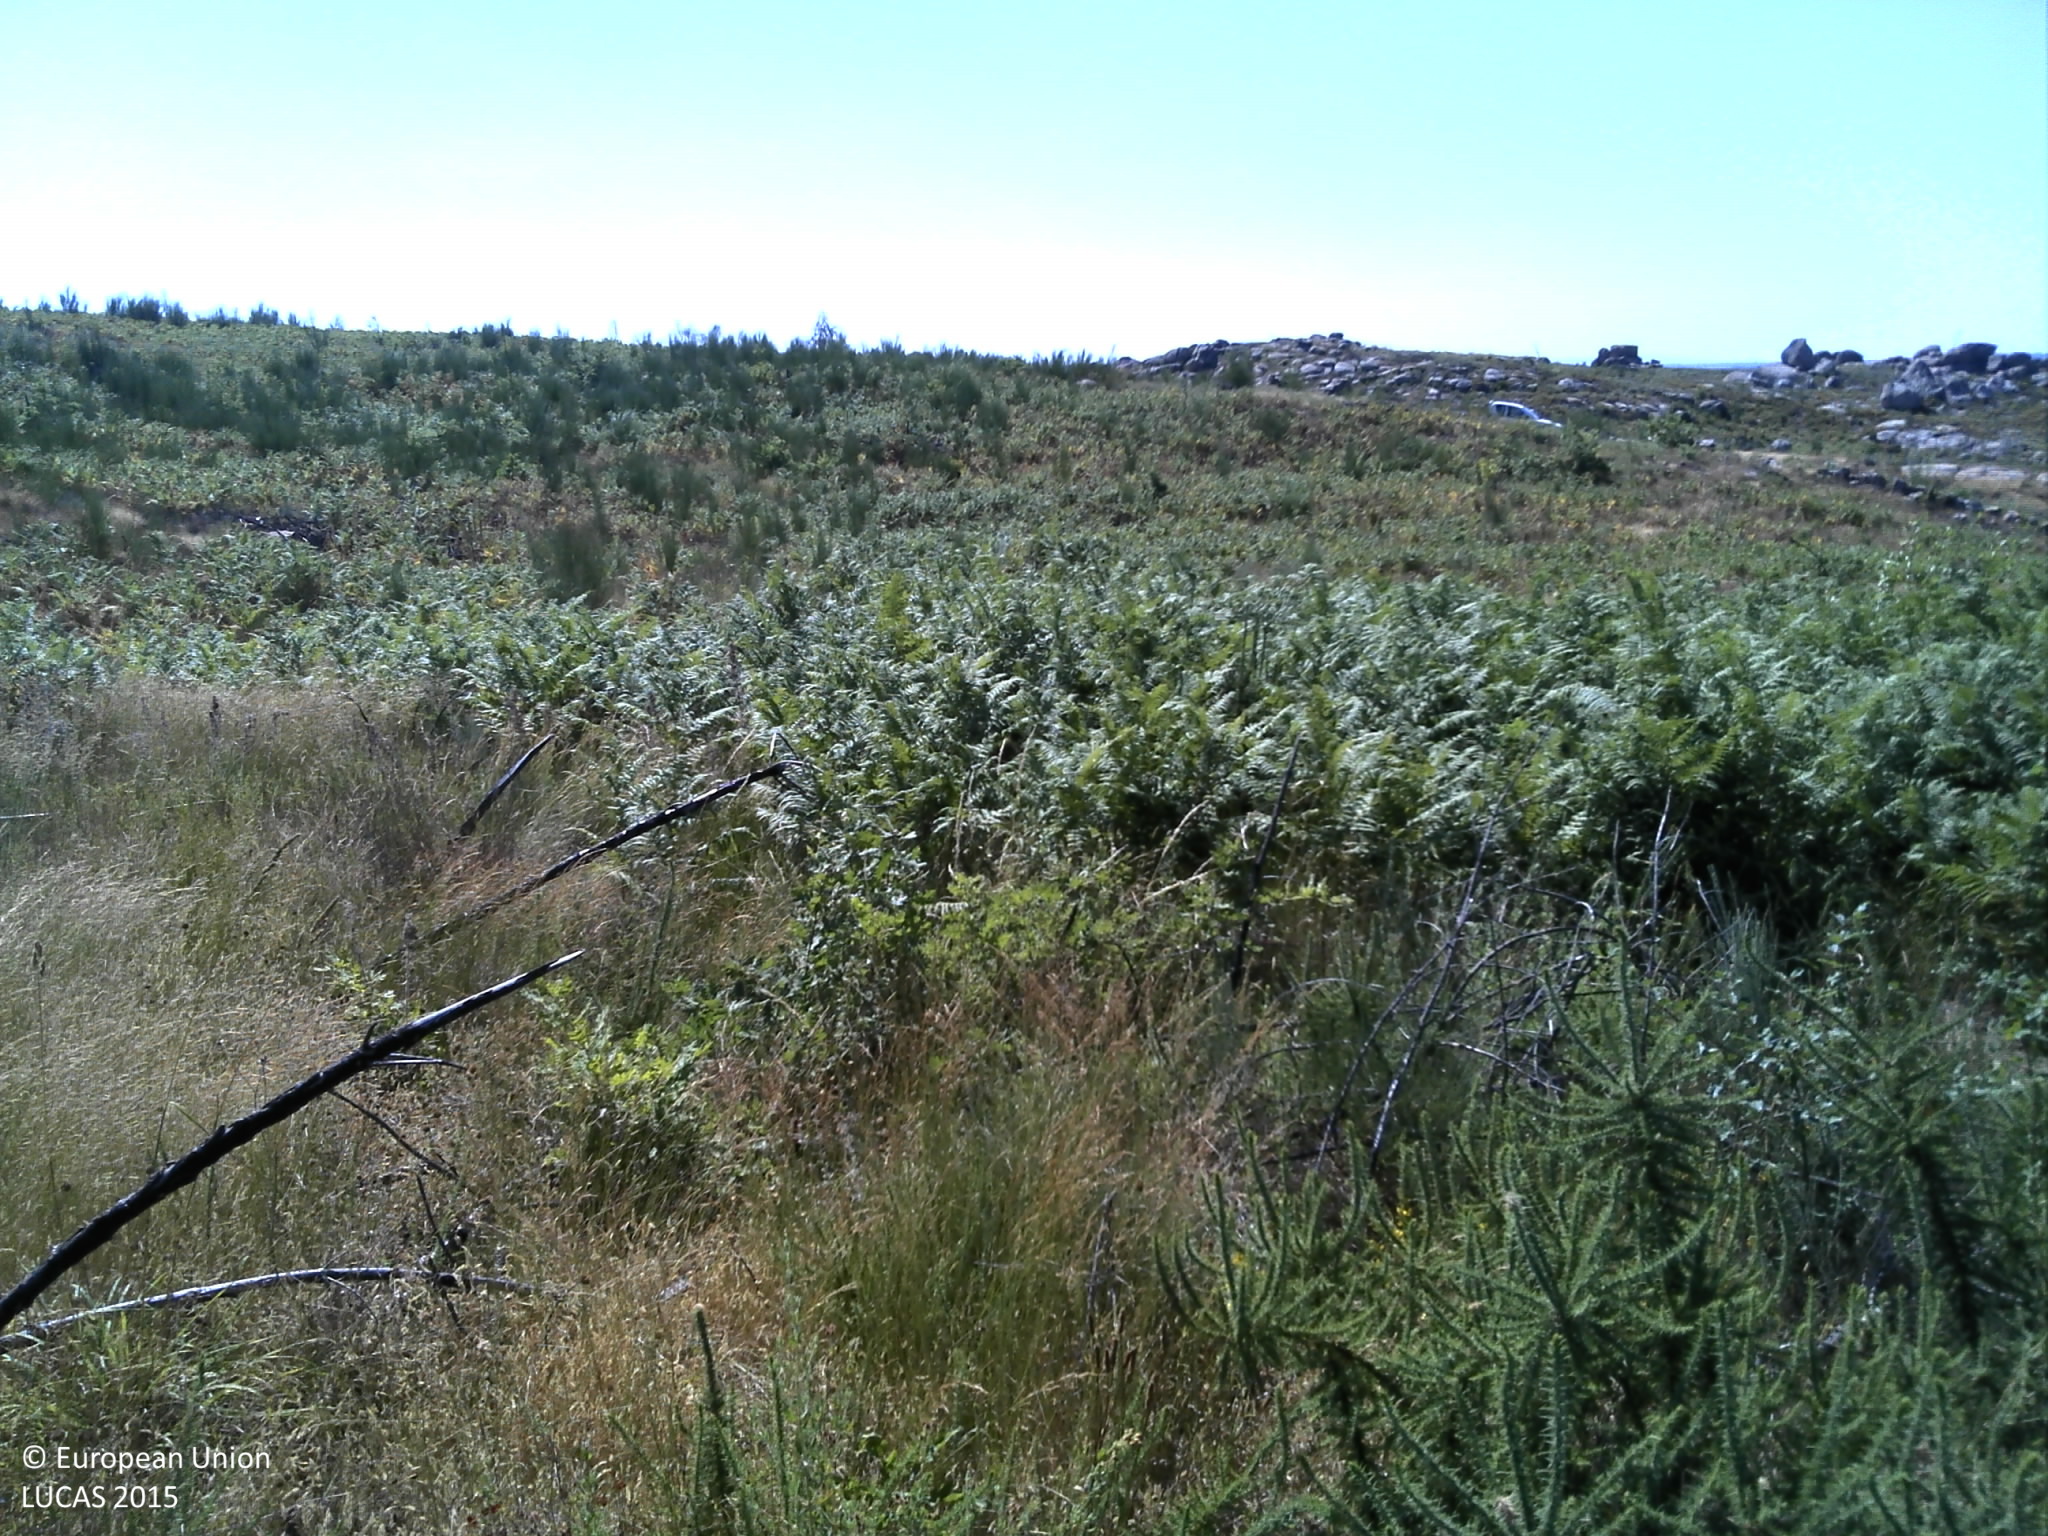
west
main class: Shrubland
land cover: Shrubland without tree cover
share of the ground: > 75 %
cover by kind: shrubs 90 %, herbaceous plants 10 %
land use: Abandoned areas
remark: Burnt area
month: July
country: PT
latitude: 40.7670
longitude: -7.4947
